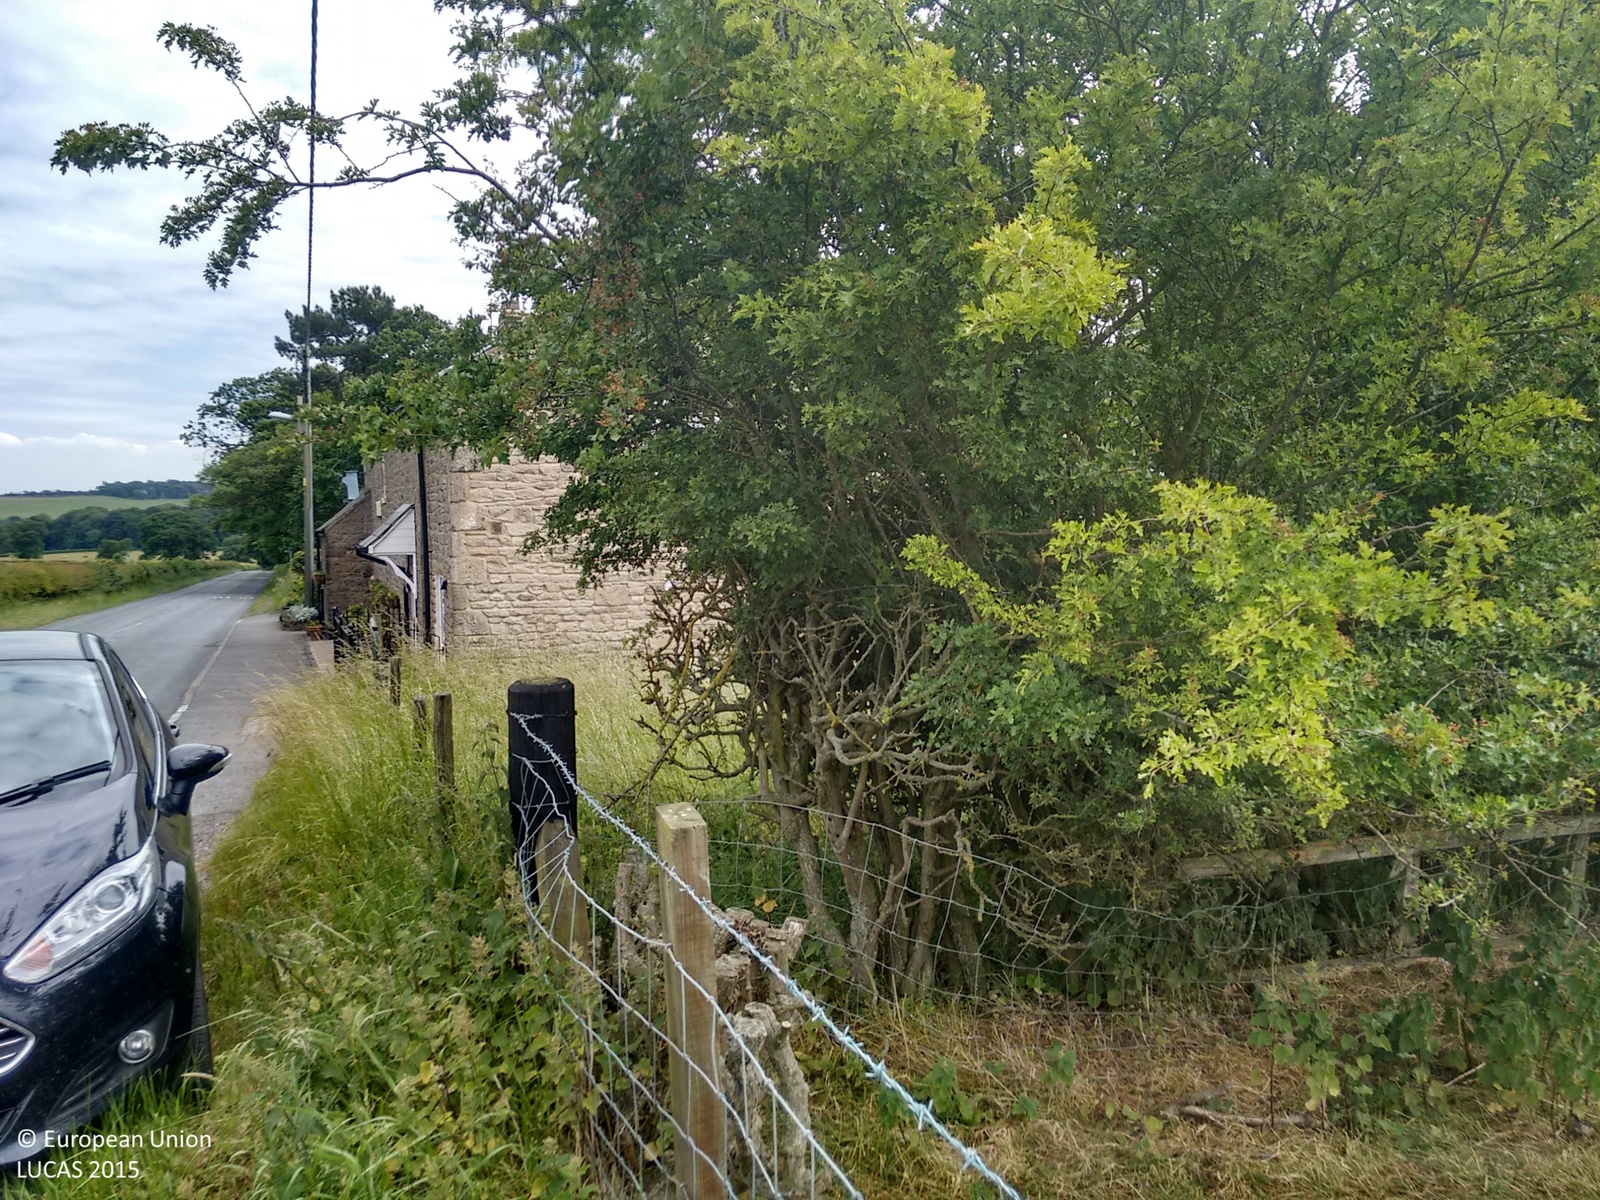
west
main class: Grassland
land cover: Grassland without tree/shrub cover
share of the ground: > 75 %
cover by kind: herbaceous plants 100 %
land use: Agriculture (excluding fallow land and kitchen gardens)
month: June
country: GB
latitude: 54.6984
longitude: -1.7670
